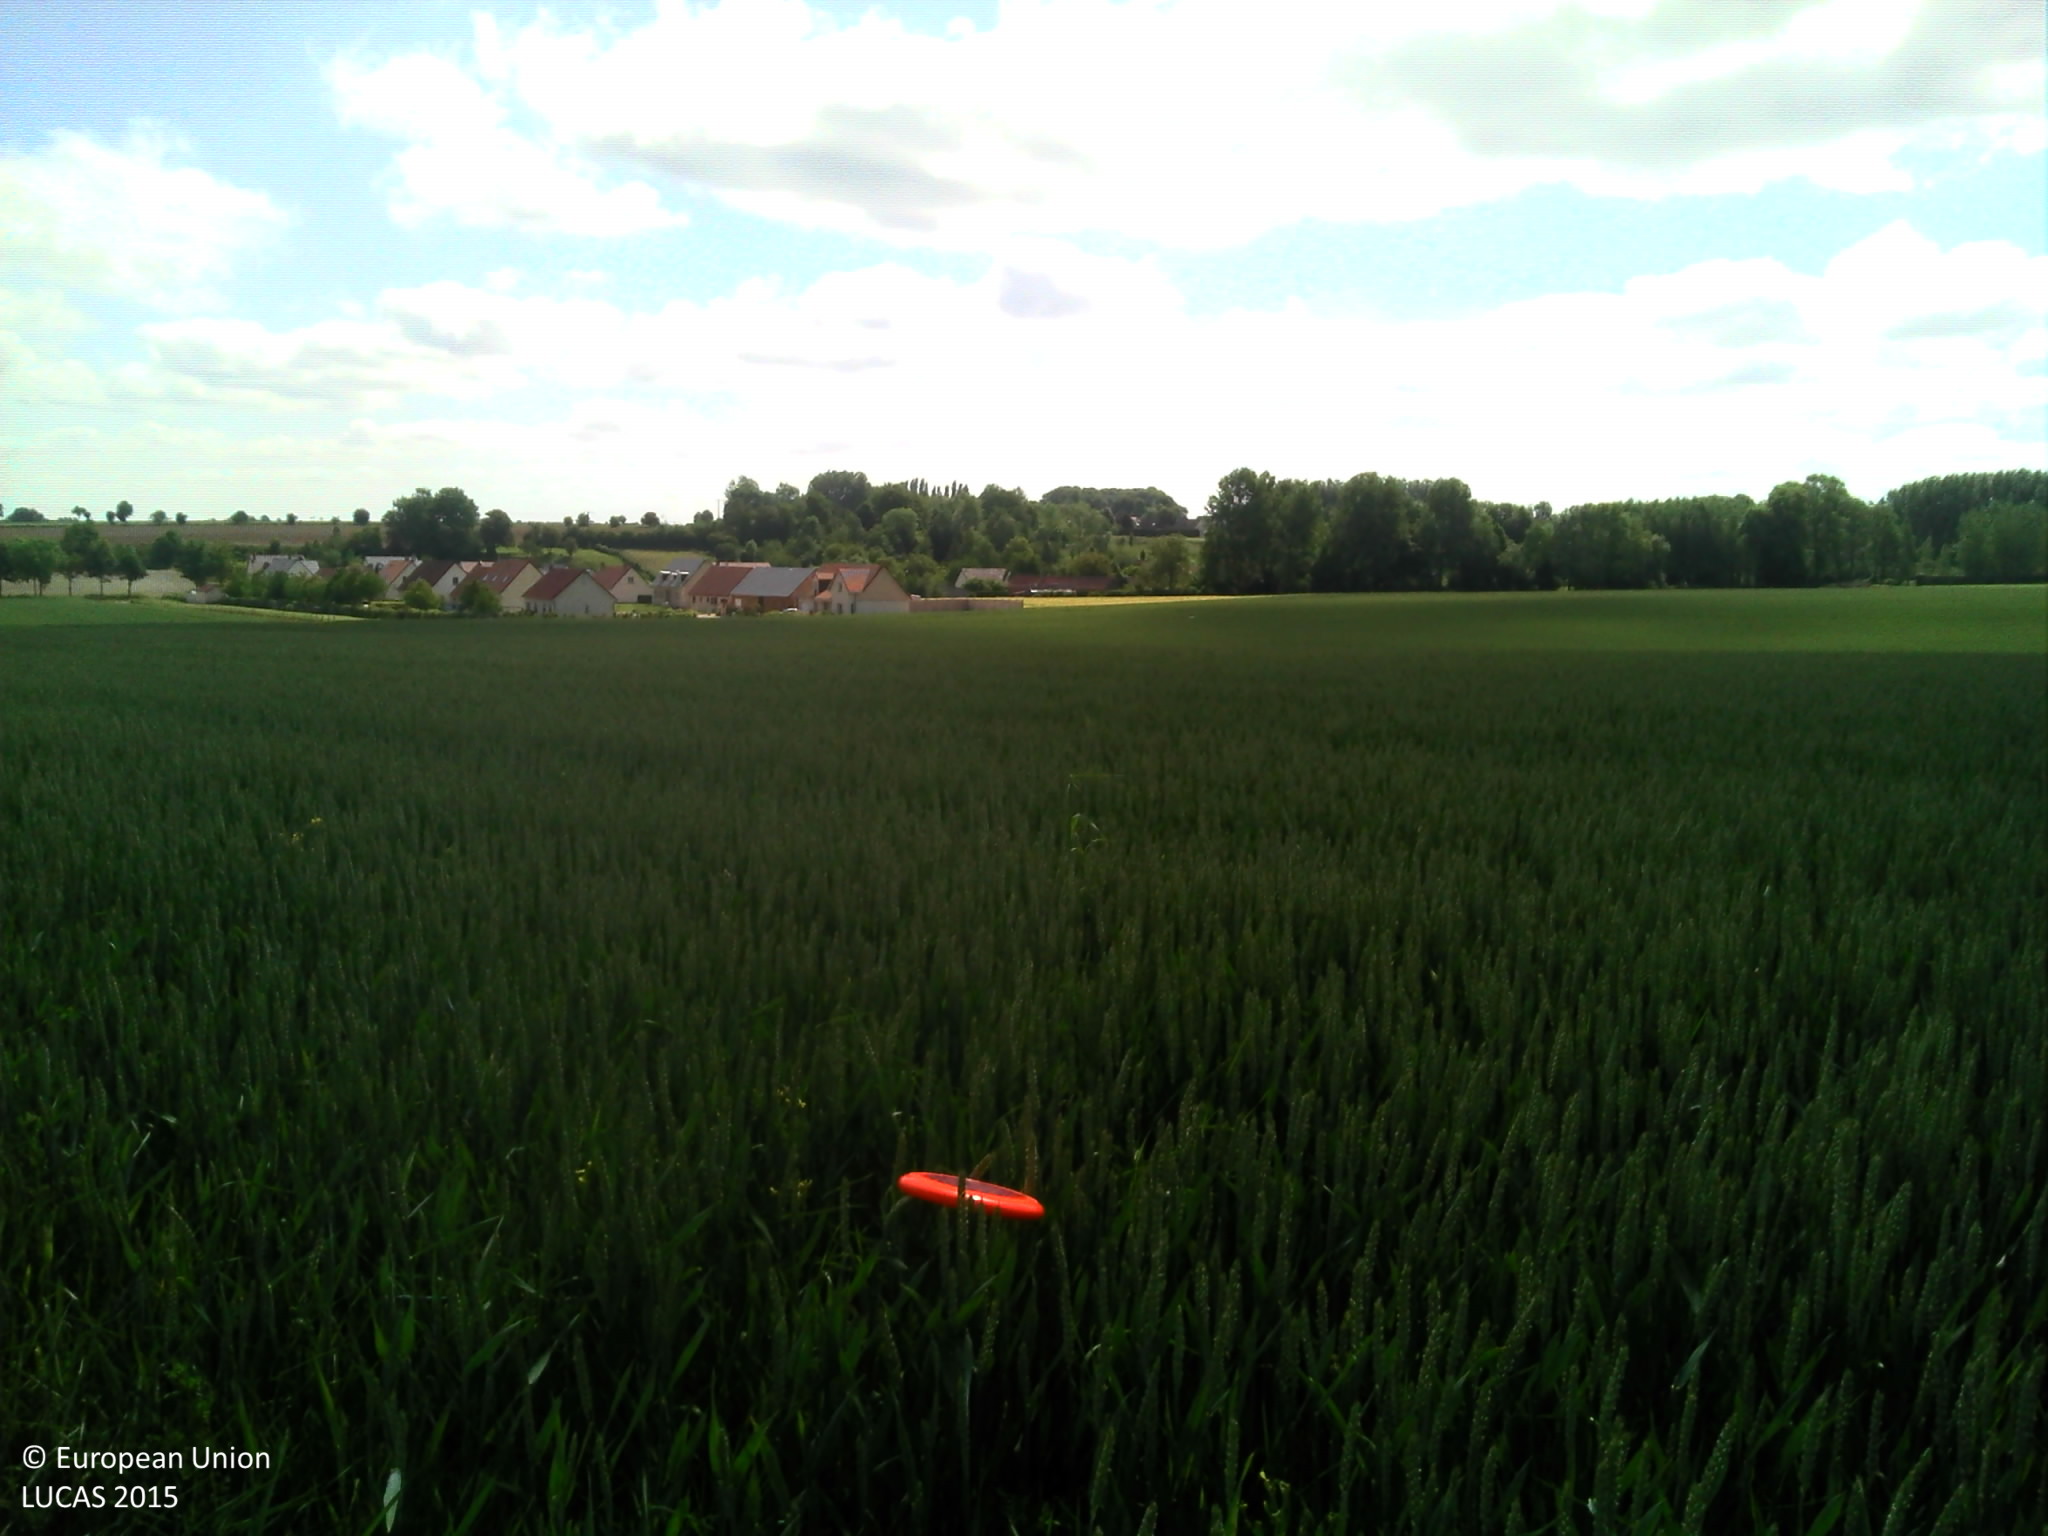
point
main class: Cropland
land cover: Common wheat
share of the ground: > 75 %
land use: Agriculture (excluding fallow land and kitchen gardens)
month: June
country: FR
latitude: 50.1073
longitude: 1.5782
